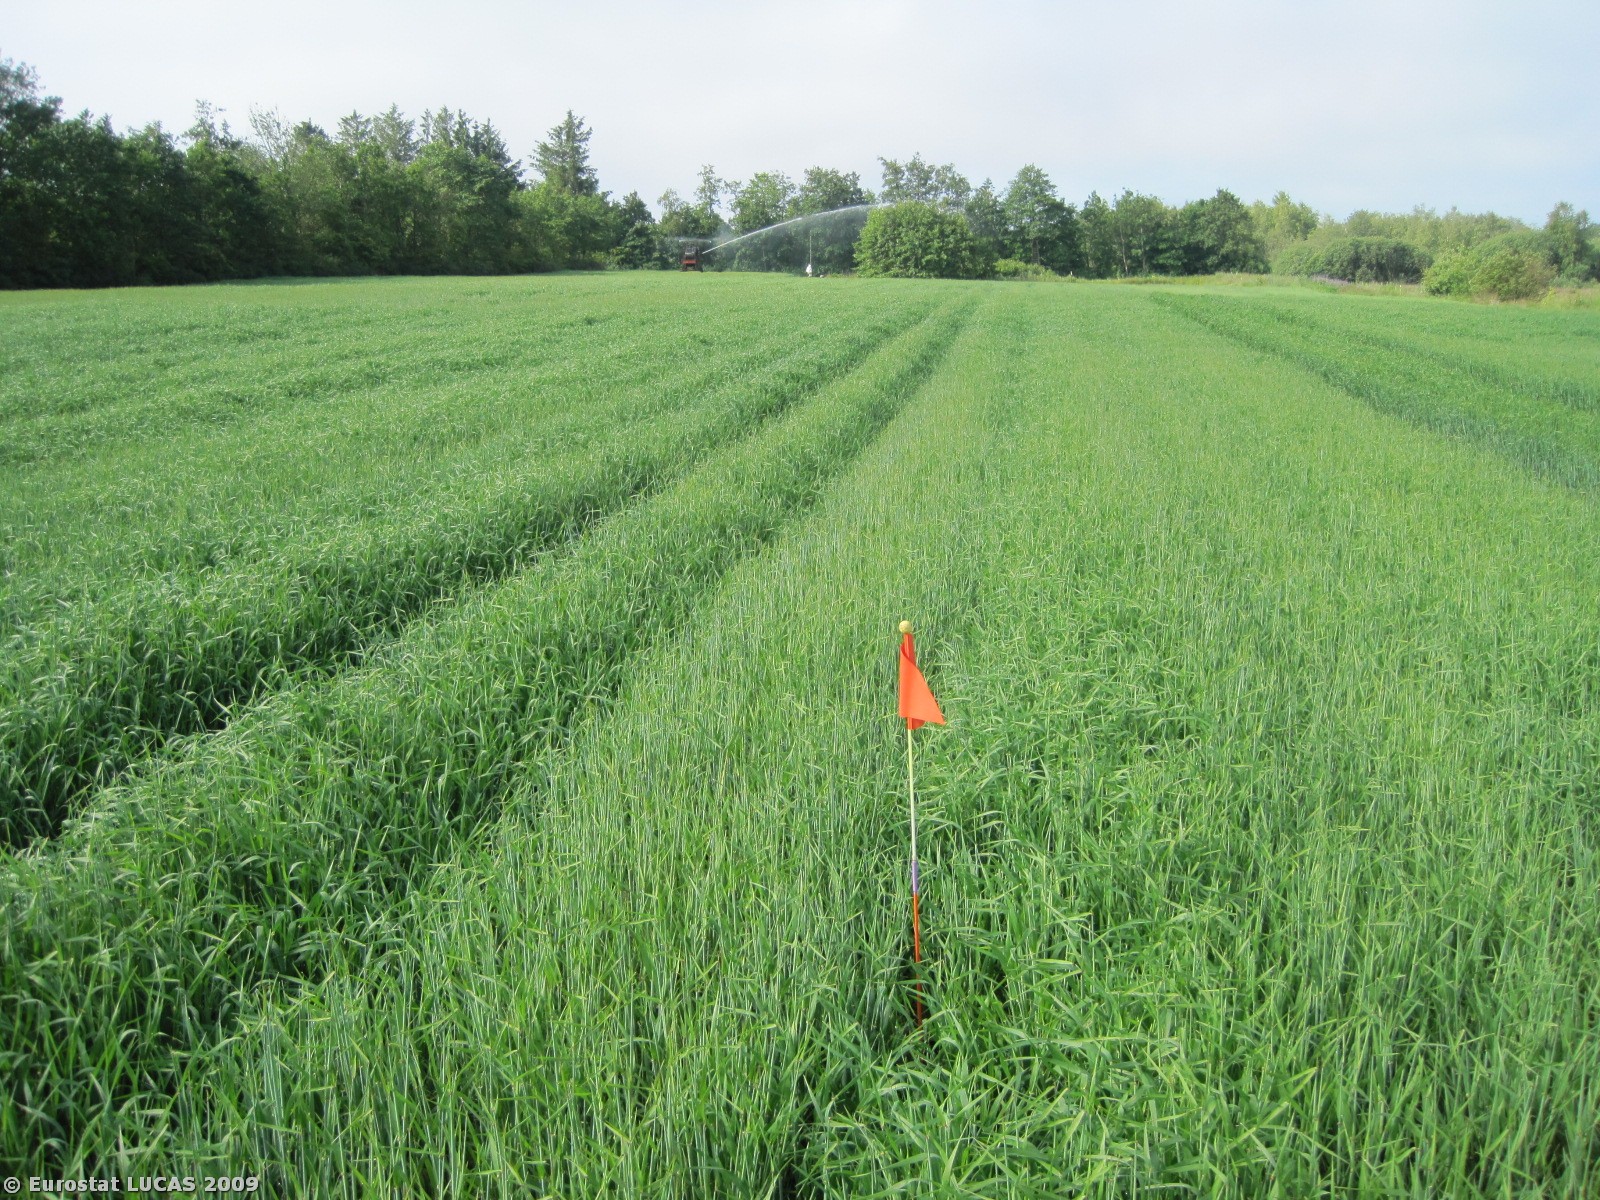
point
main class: Cropland
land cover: Barley
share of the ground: > 75 %
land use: Agriculture (excluding fallow land and kitchen gardens)
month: June
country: DK
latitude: 56.3275
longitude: 8.9824
